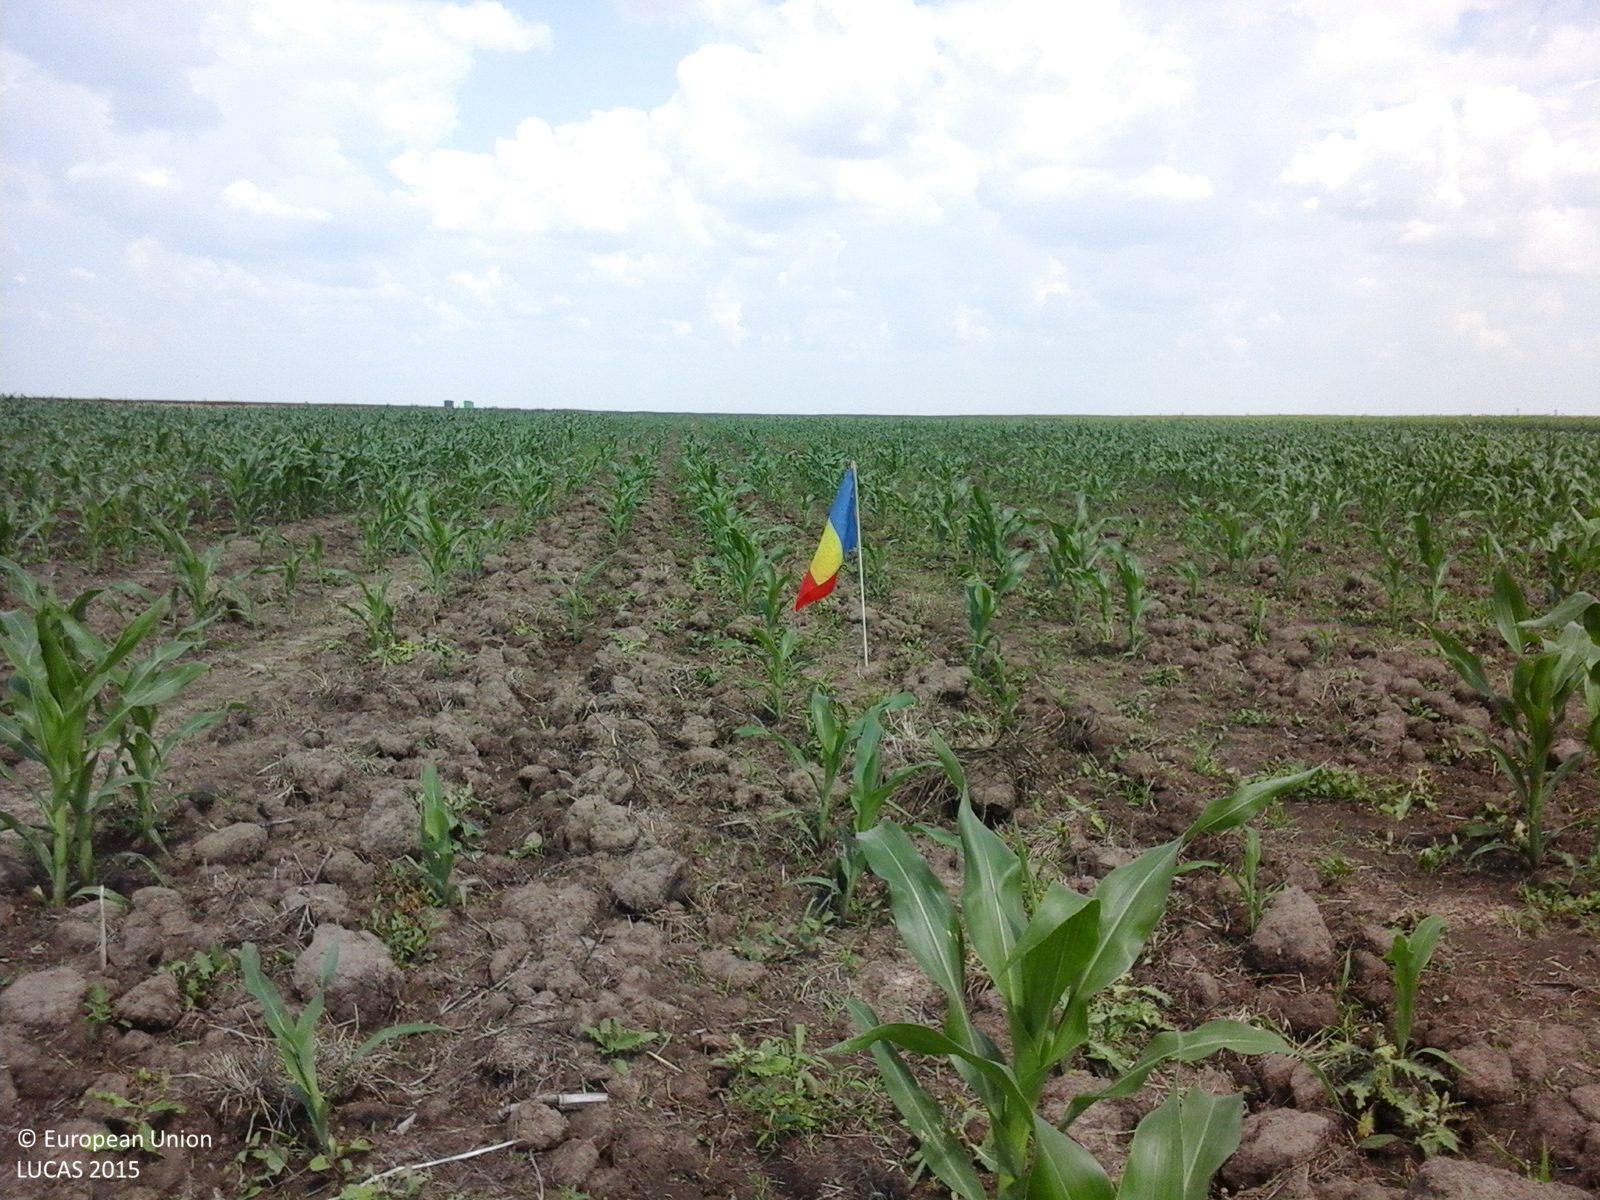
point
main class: Cropland
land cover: Maize
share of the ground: 25 - 50 %
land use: Agriculture (excluding fallow land and kitchen gardens)
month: July
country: RO
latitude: 44.0339
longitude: 25.2934
